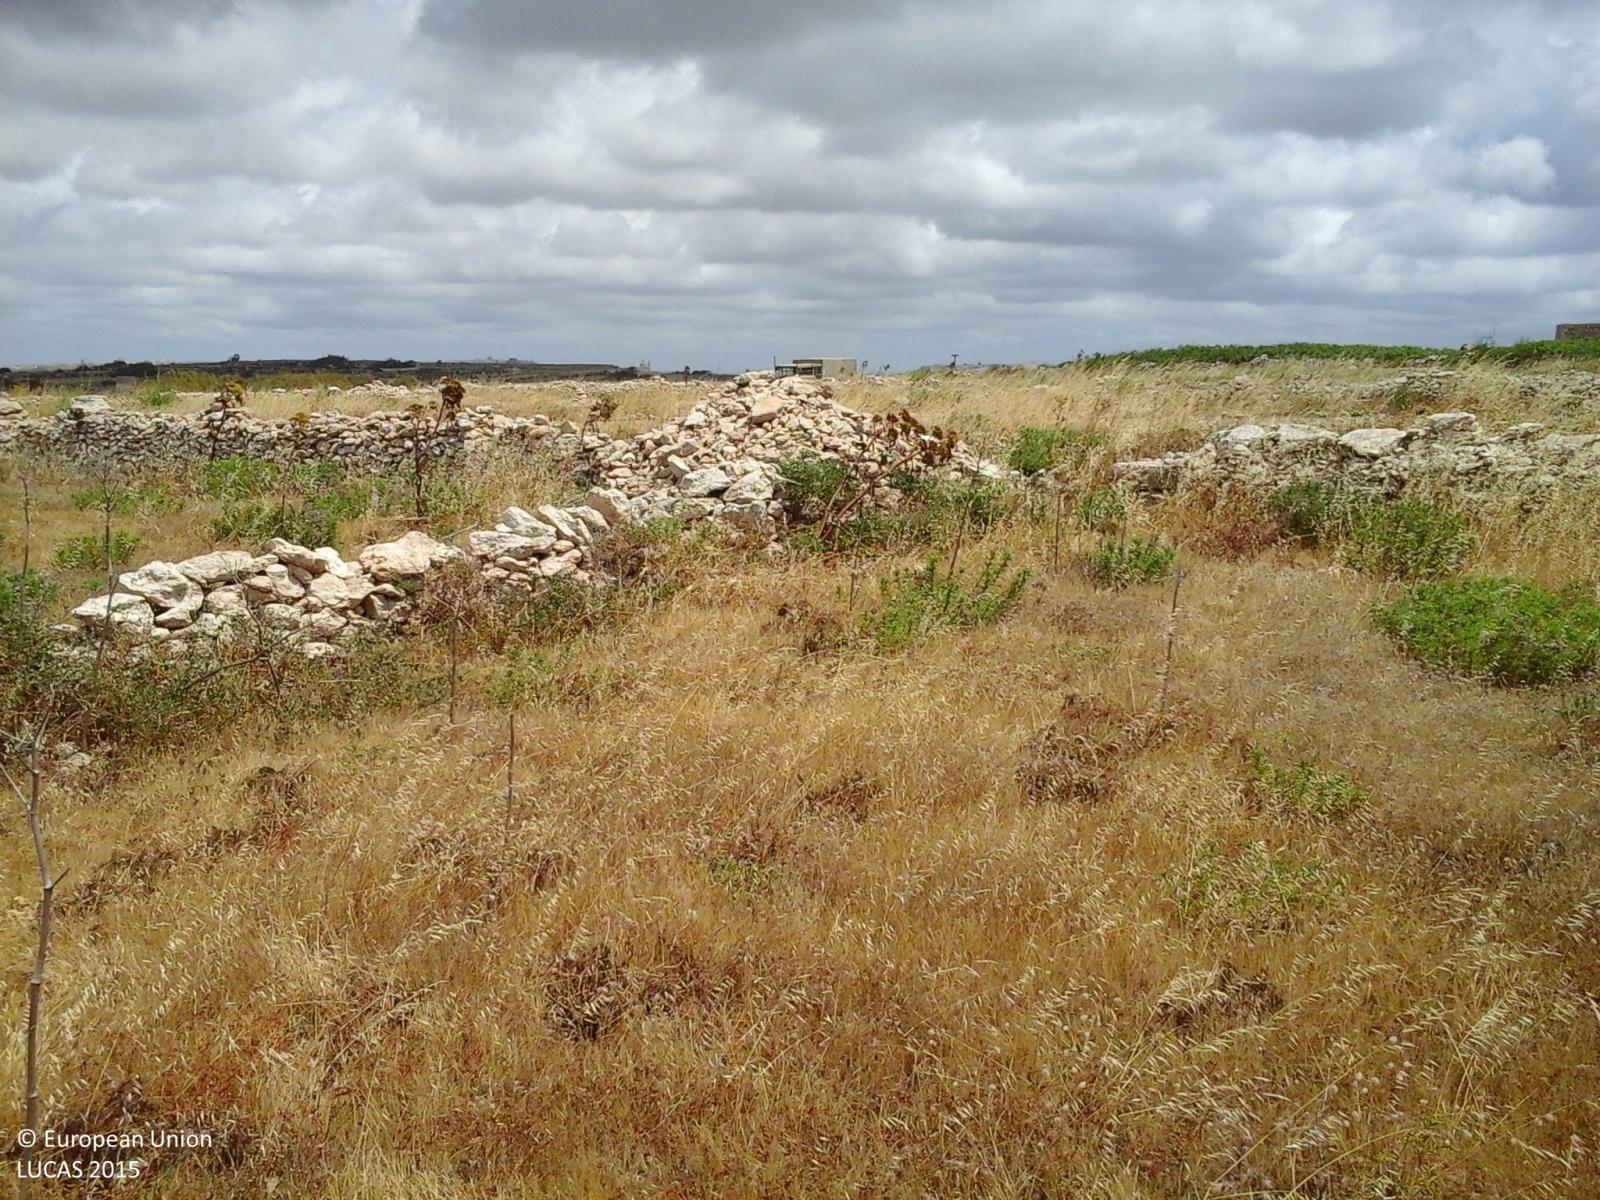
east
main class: Grassland
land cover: Grassland without tree/shrub cover
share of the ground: > 75 %
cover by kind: herbaceous plants 95 %
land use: Abandoned areas
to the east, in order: Grassland without tree/shrub cover; Dry stone walls; Grassland without tree/shrub cover; Dry stone walls; Grassland without tree/shrub cover; Other bare soil; Grassland without tree/shrub cover; Dry stone walls; Grassland without tree/shrub cover; Dry stone walls; Tracks; Dry stone walls; Grassland without tree/shrub cover; Dry stone walls; Other leguminous and mixtures for fodder; Dry stone walls; Tracks; Dry stone walls; Mixed cereals for fodder; Dry stone walls; Mixed cereals for fodder; Spontaneously vegetated surfaces; Tracks; Mixed cereals for fodder
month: May
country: MT
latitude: 36.0360
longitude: 14.1902
